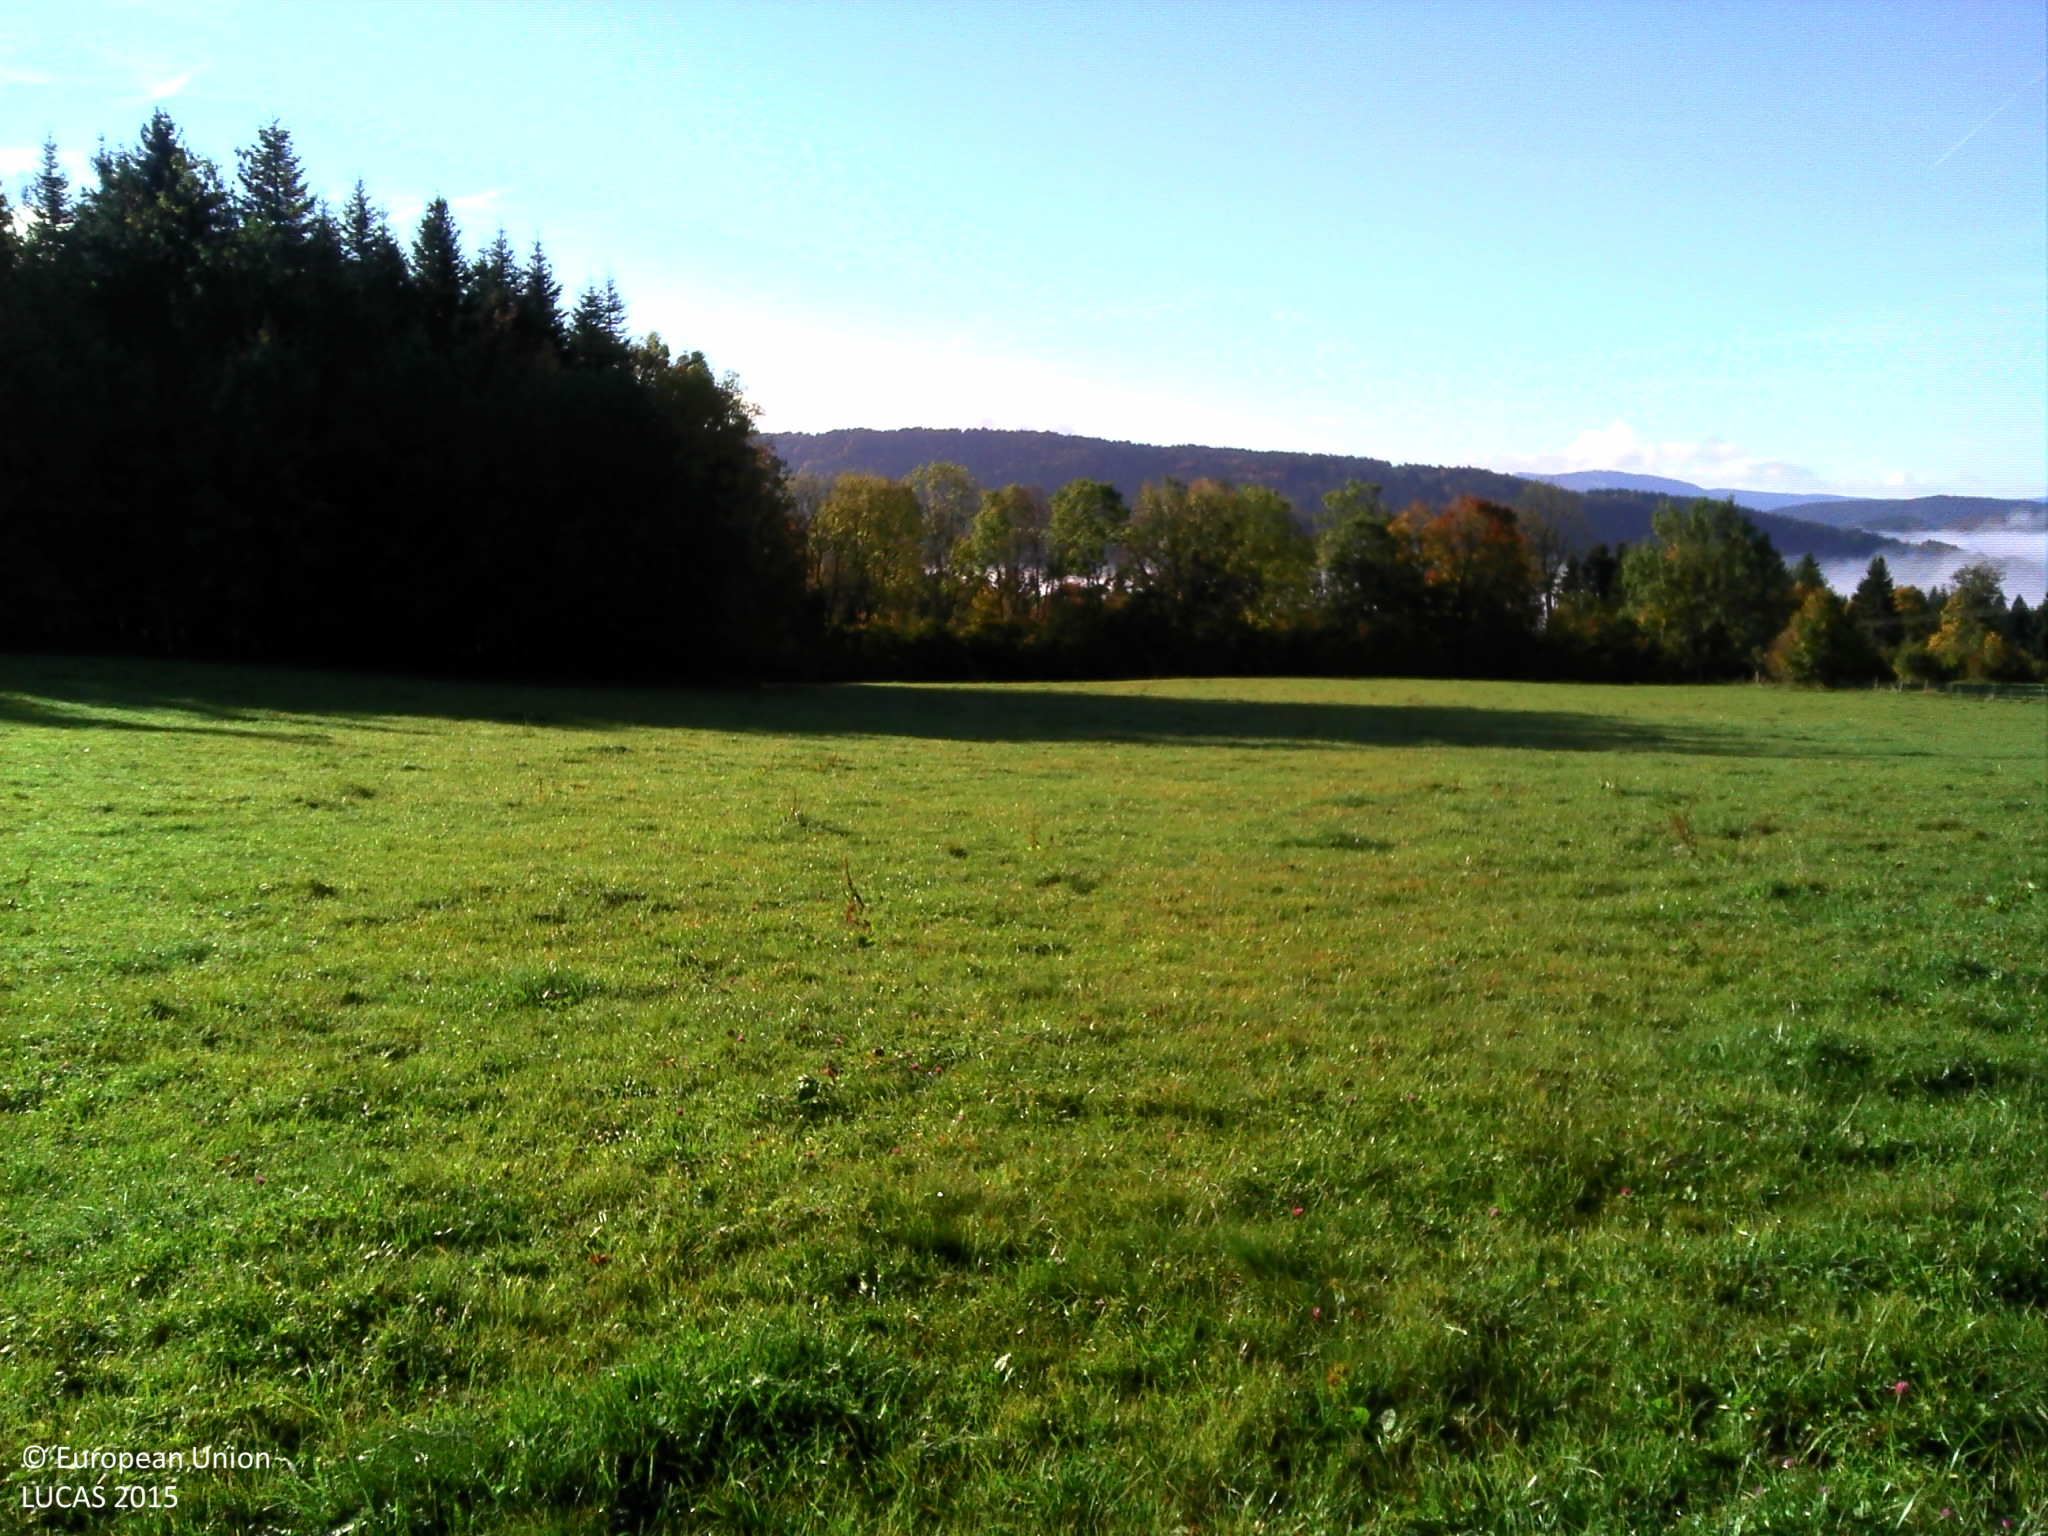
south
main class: Grassland
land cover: Grassland without tree/shrub cover
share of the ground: > 75 %
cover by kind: herbaceous plants 100 %
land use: Agriculture (excluding fallow land and kitchen gardens)
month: October
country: FR
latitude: 46.8853
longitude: 6.3936
